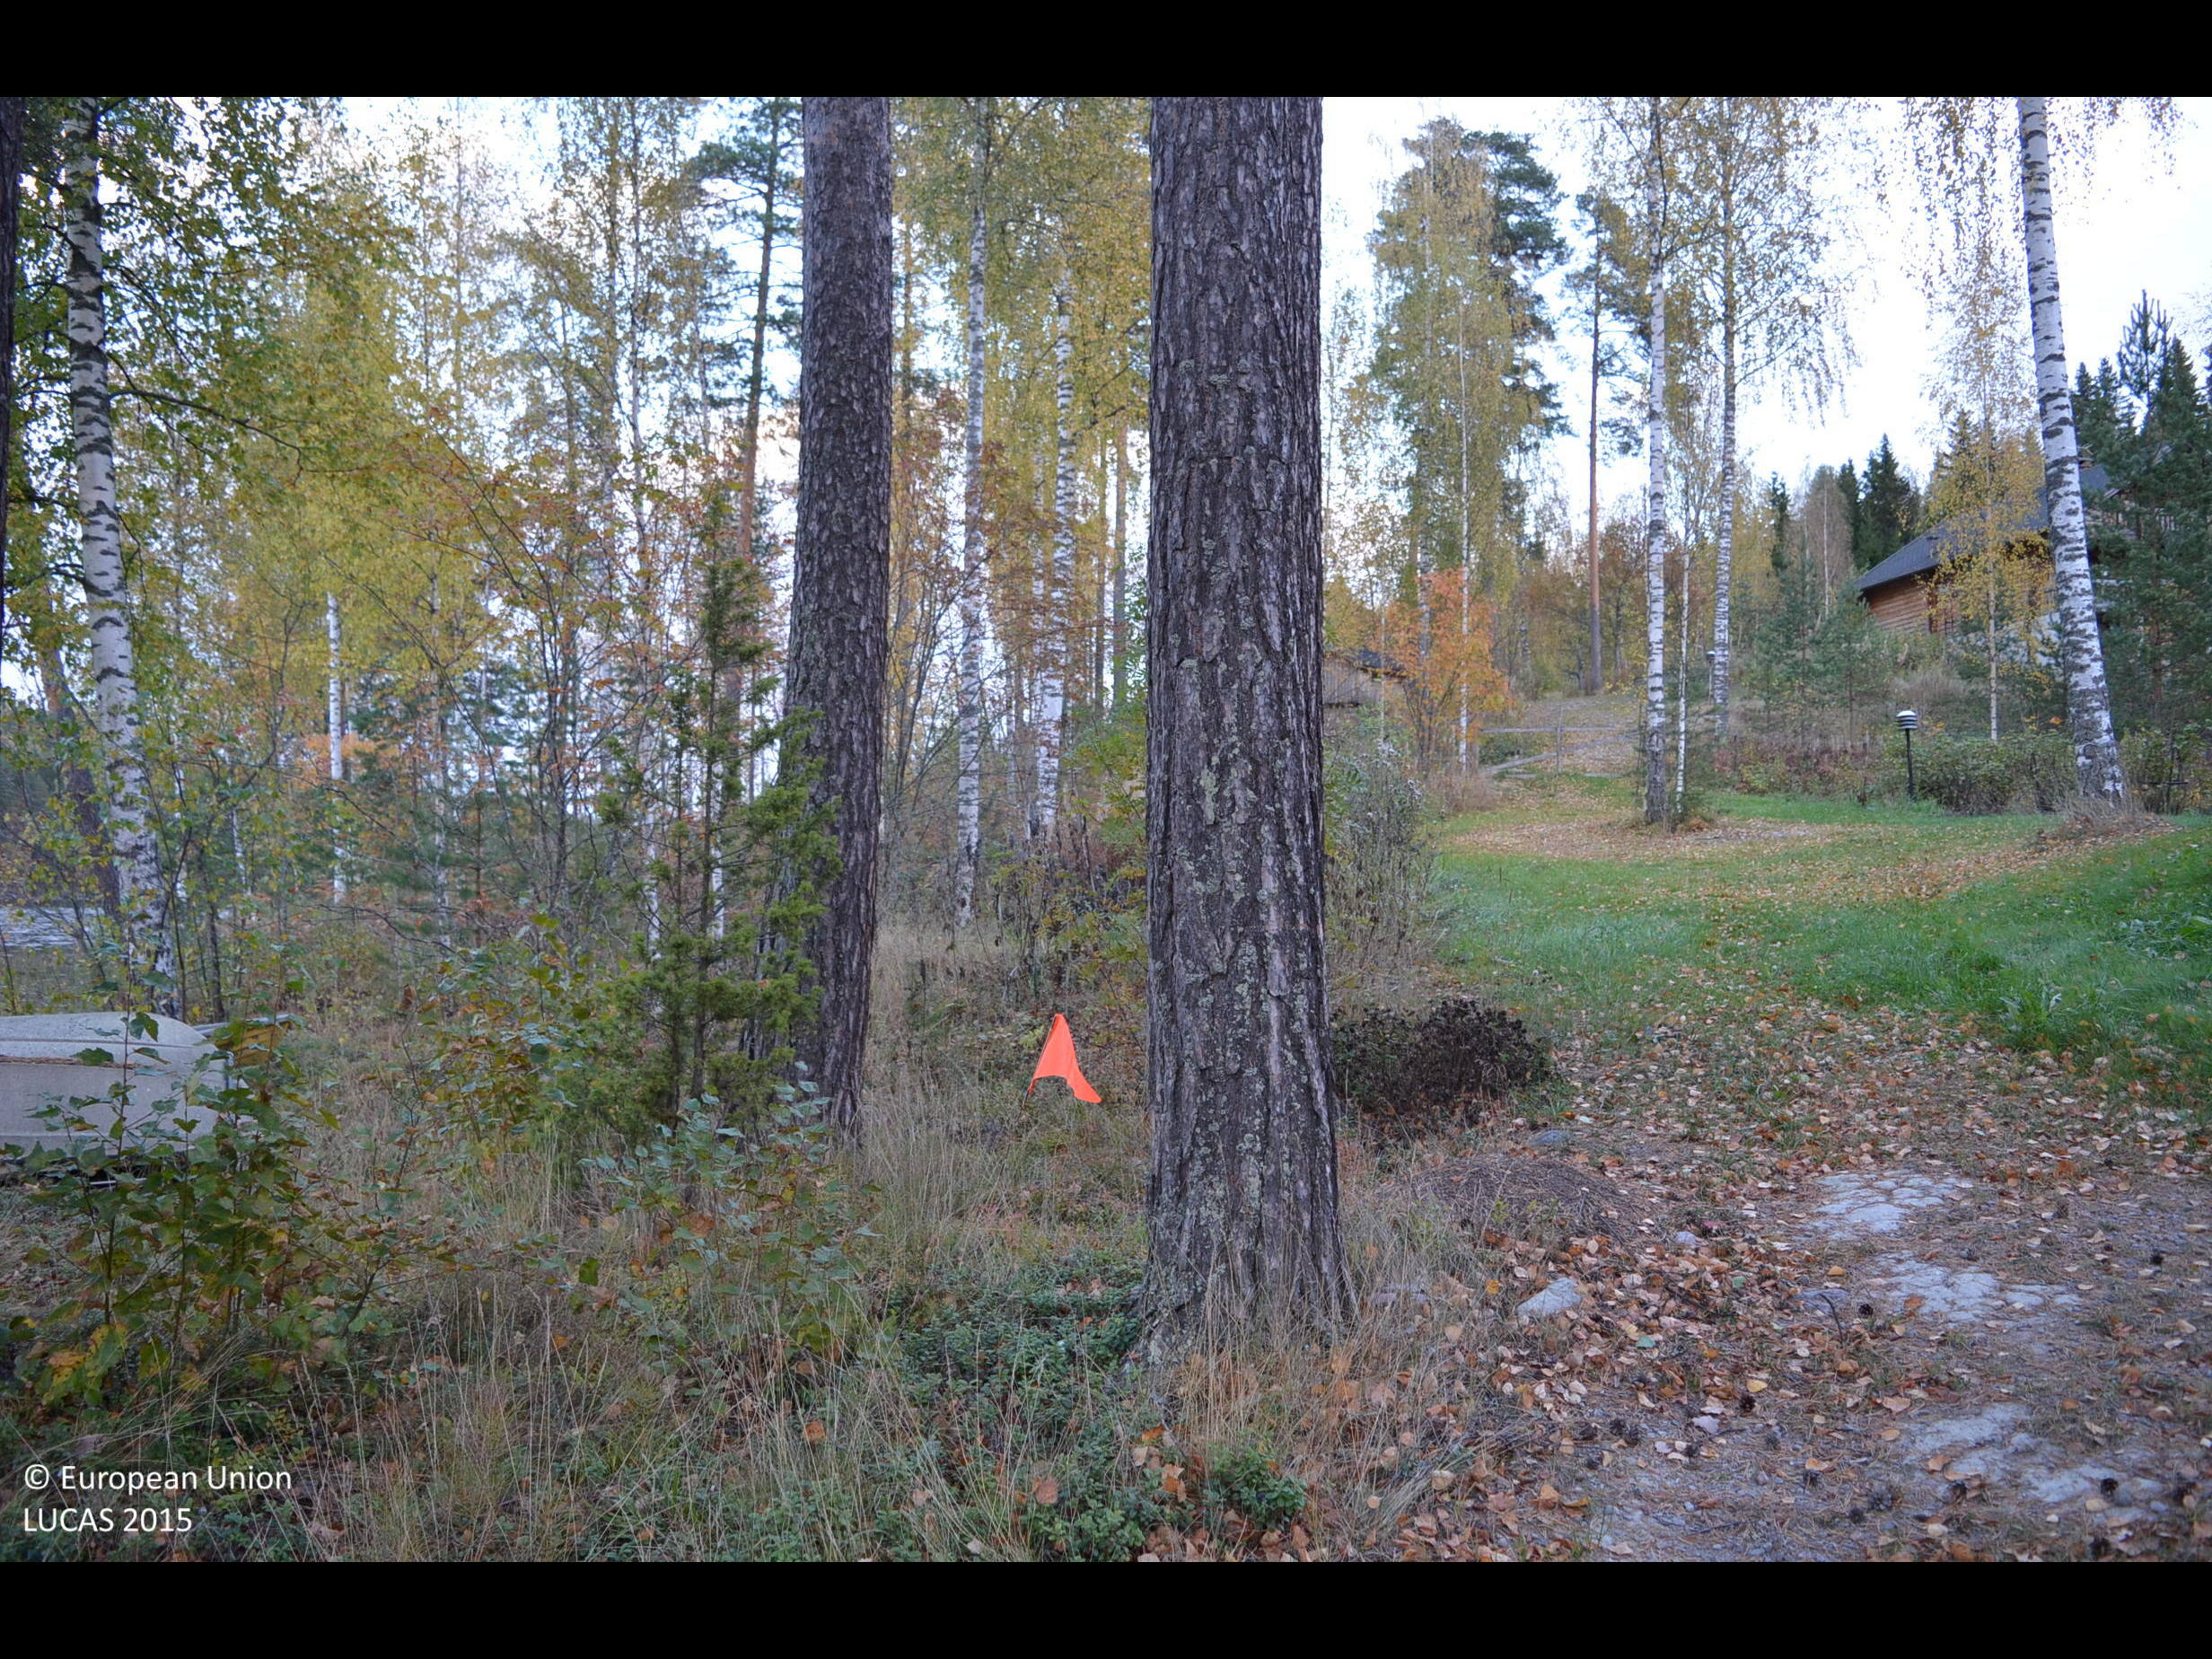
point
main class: Woodland
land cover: Other mixed woodland
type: boreal forest
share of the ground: 50 - 75 %
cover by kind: herbaceous plants 40 %, coniferous forest trees 25 %, broadleaved forest trees 25 %, shrubs 10 %
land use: Residential
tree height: > 5 m
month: October
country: FI
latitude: 61.6351
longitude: 23.8781
